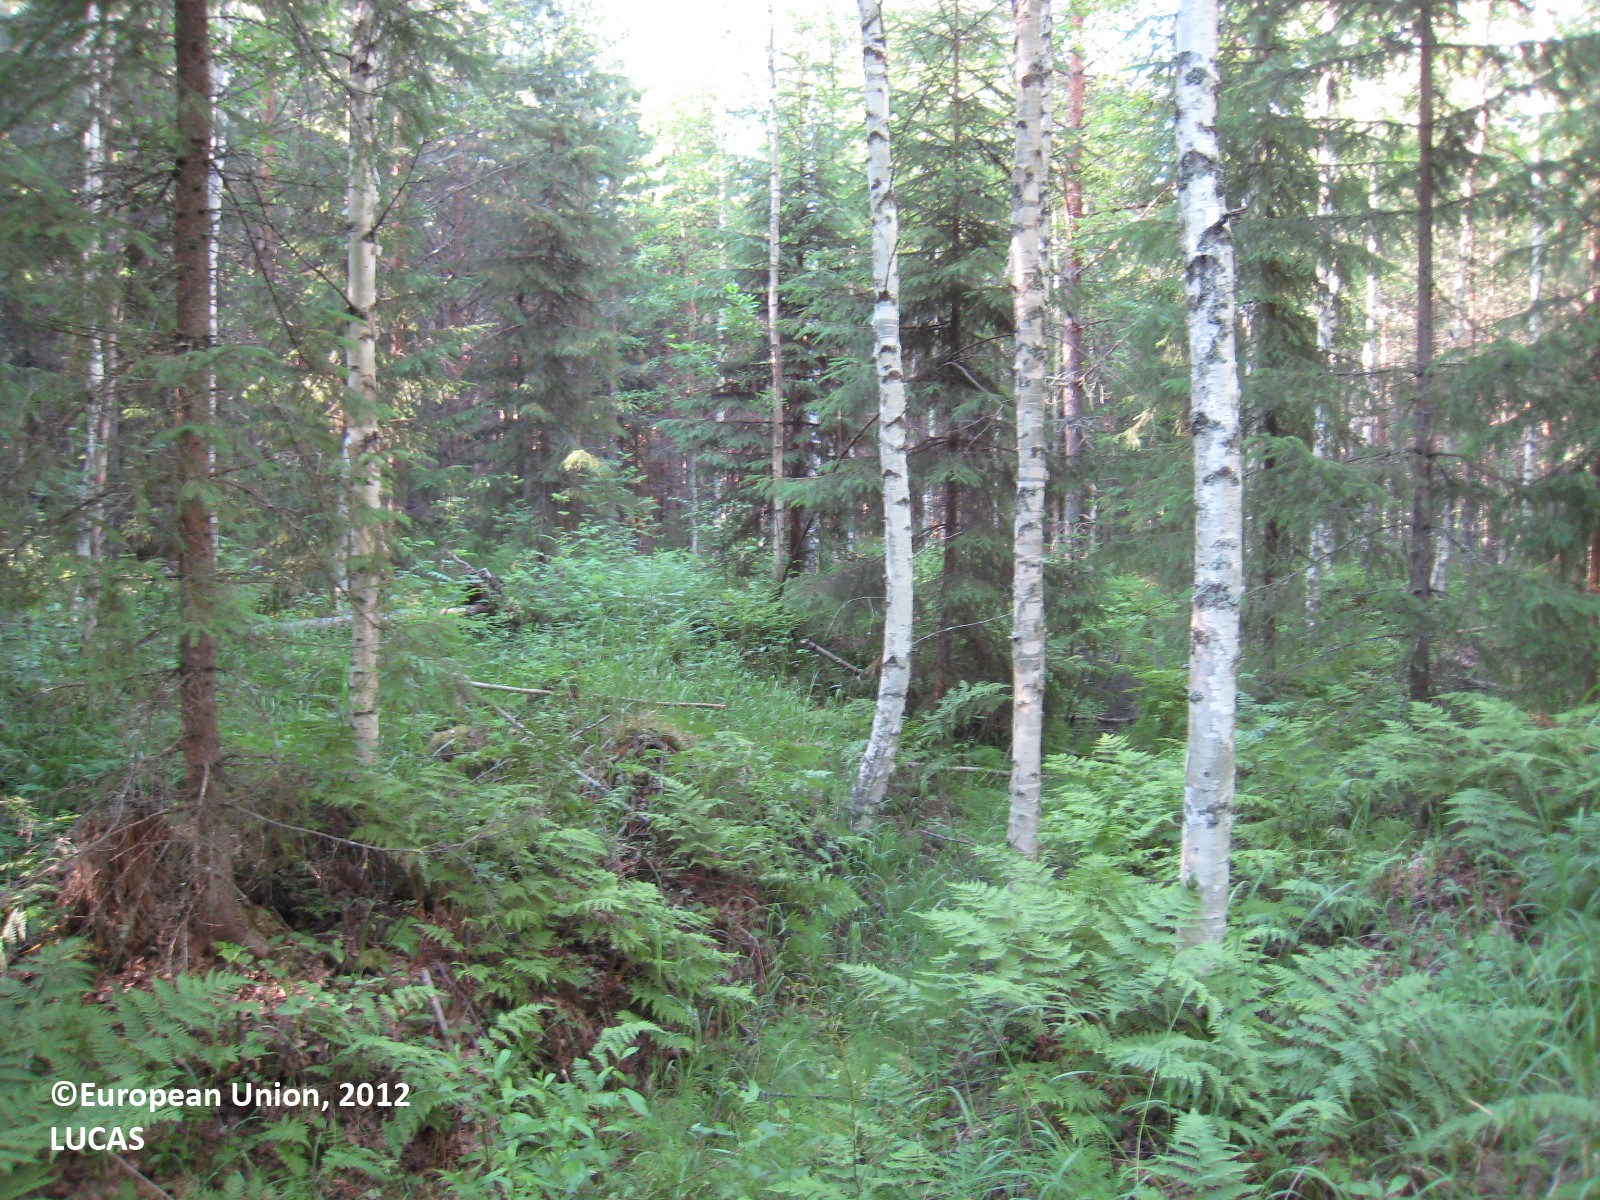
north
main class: Woodland
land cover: Other mixed woodland
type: boreal forest
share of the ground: > 75 %
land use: Forestry
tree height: > 5 m
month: July
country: FI
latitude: 63.1190
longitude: 25.7936
